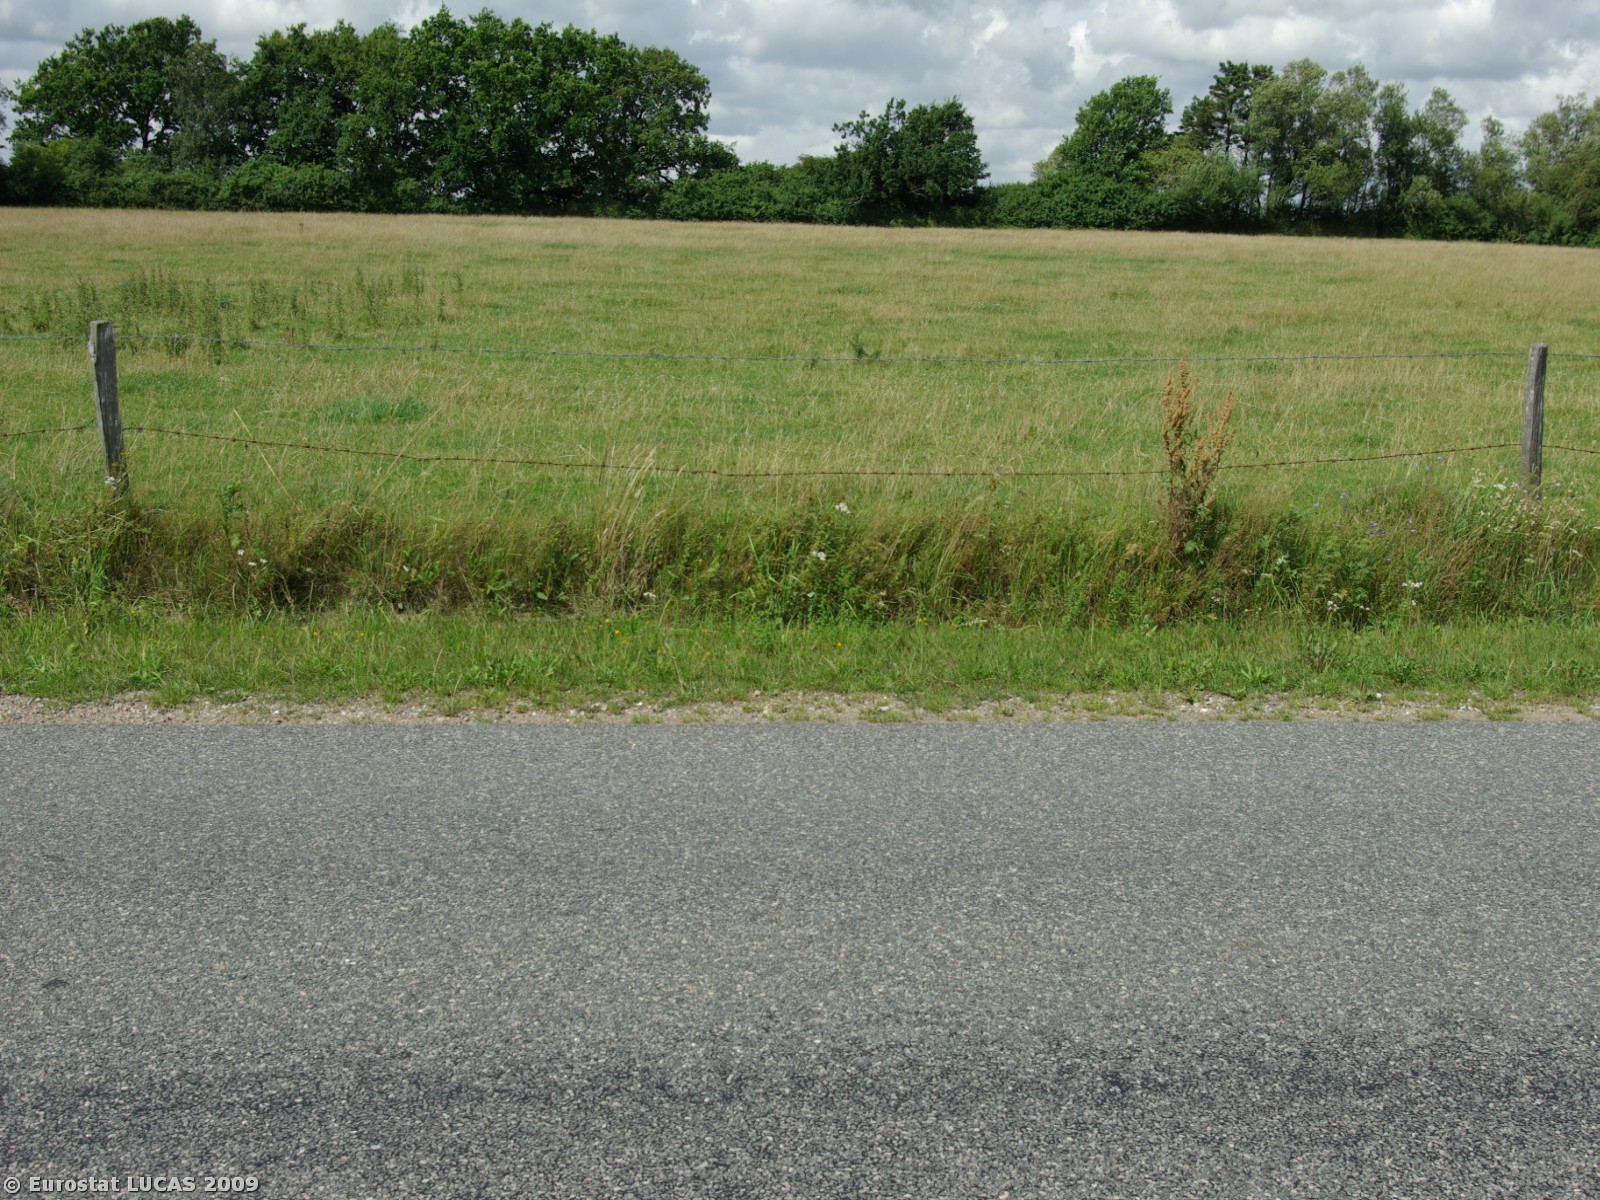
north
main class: Cropland
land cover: Barley
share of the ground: > 75 %
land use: Agriculture (excluding fallow land and kitchen gardens)
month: July
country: DK
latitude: 55.0507
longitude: 8.9208
